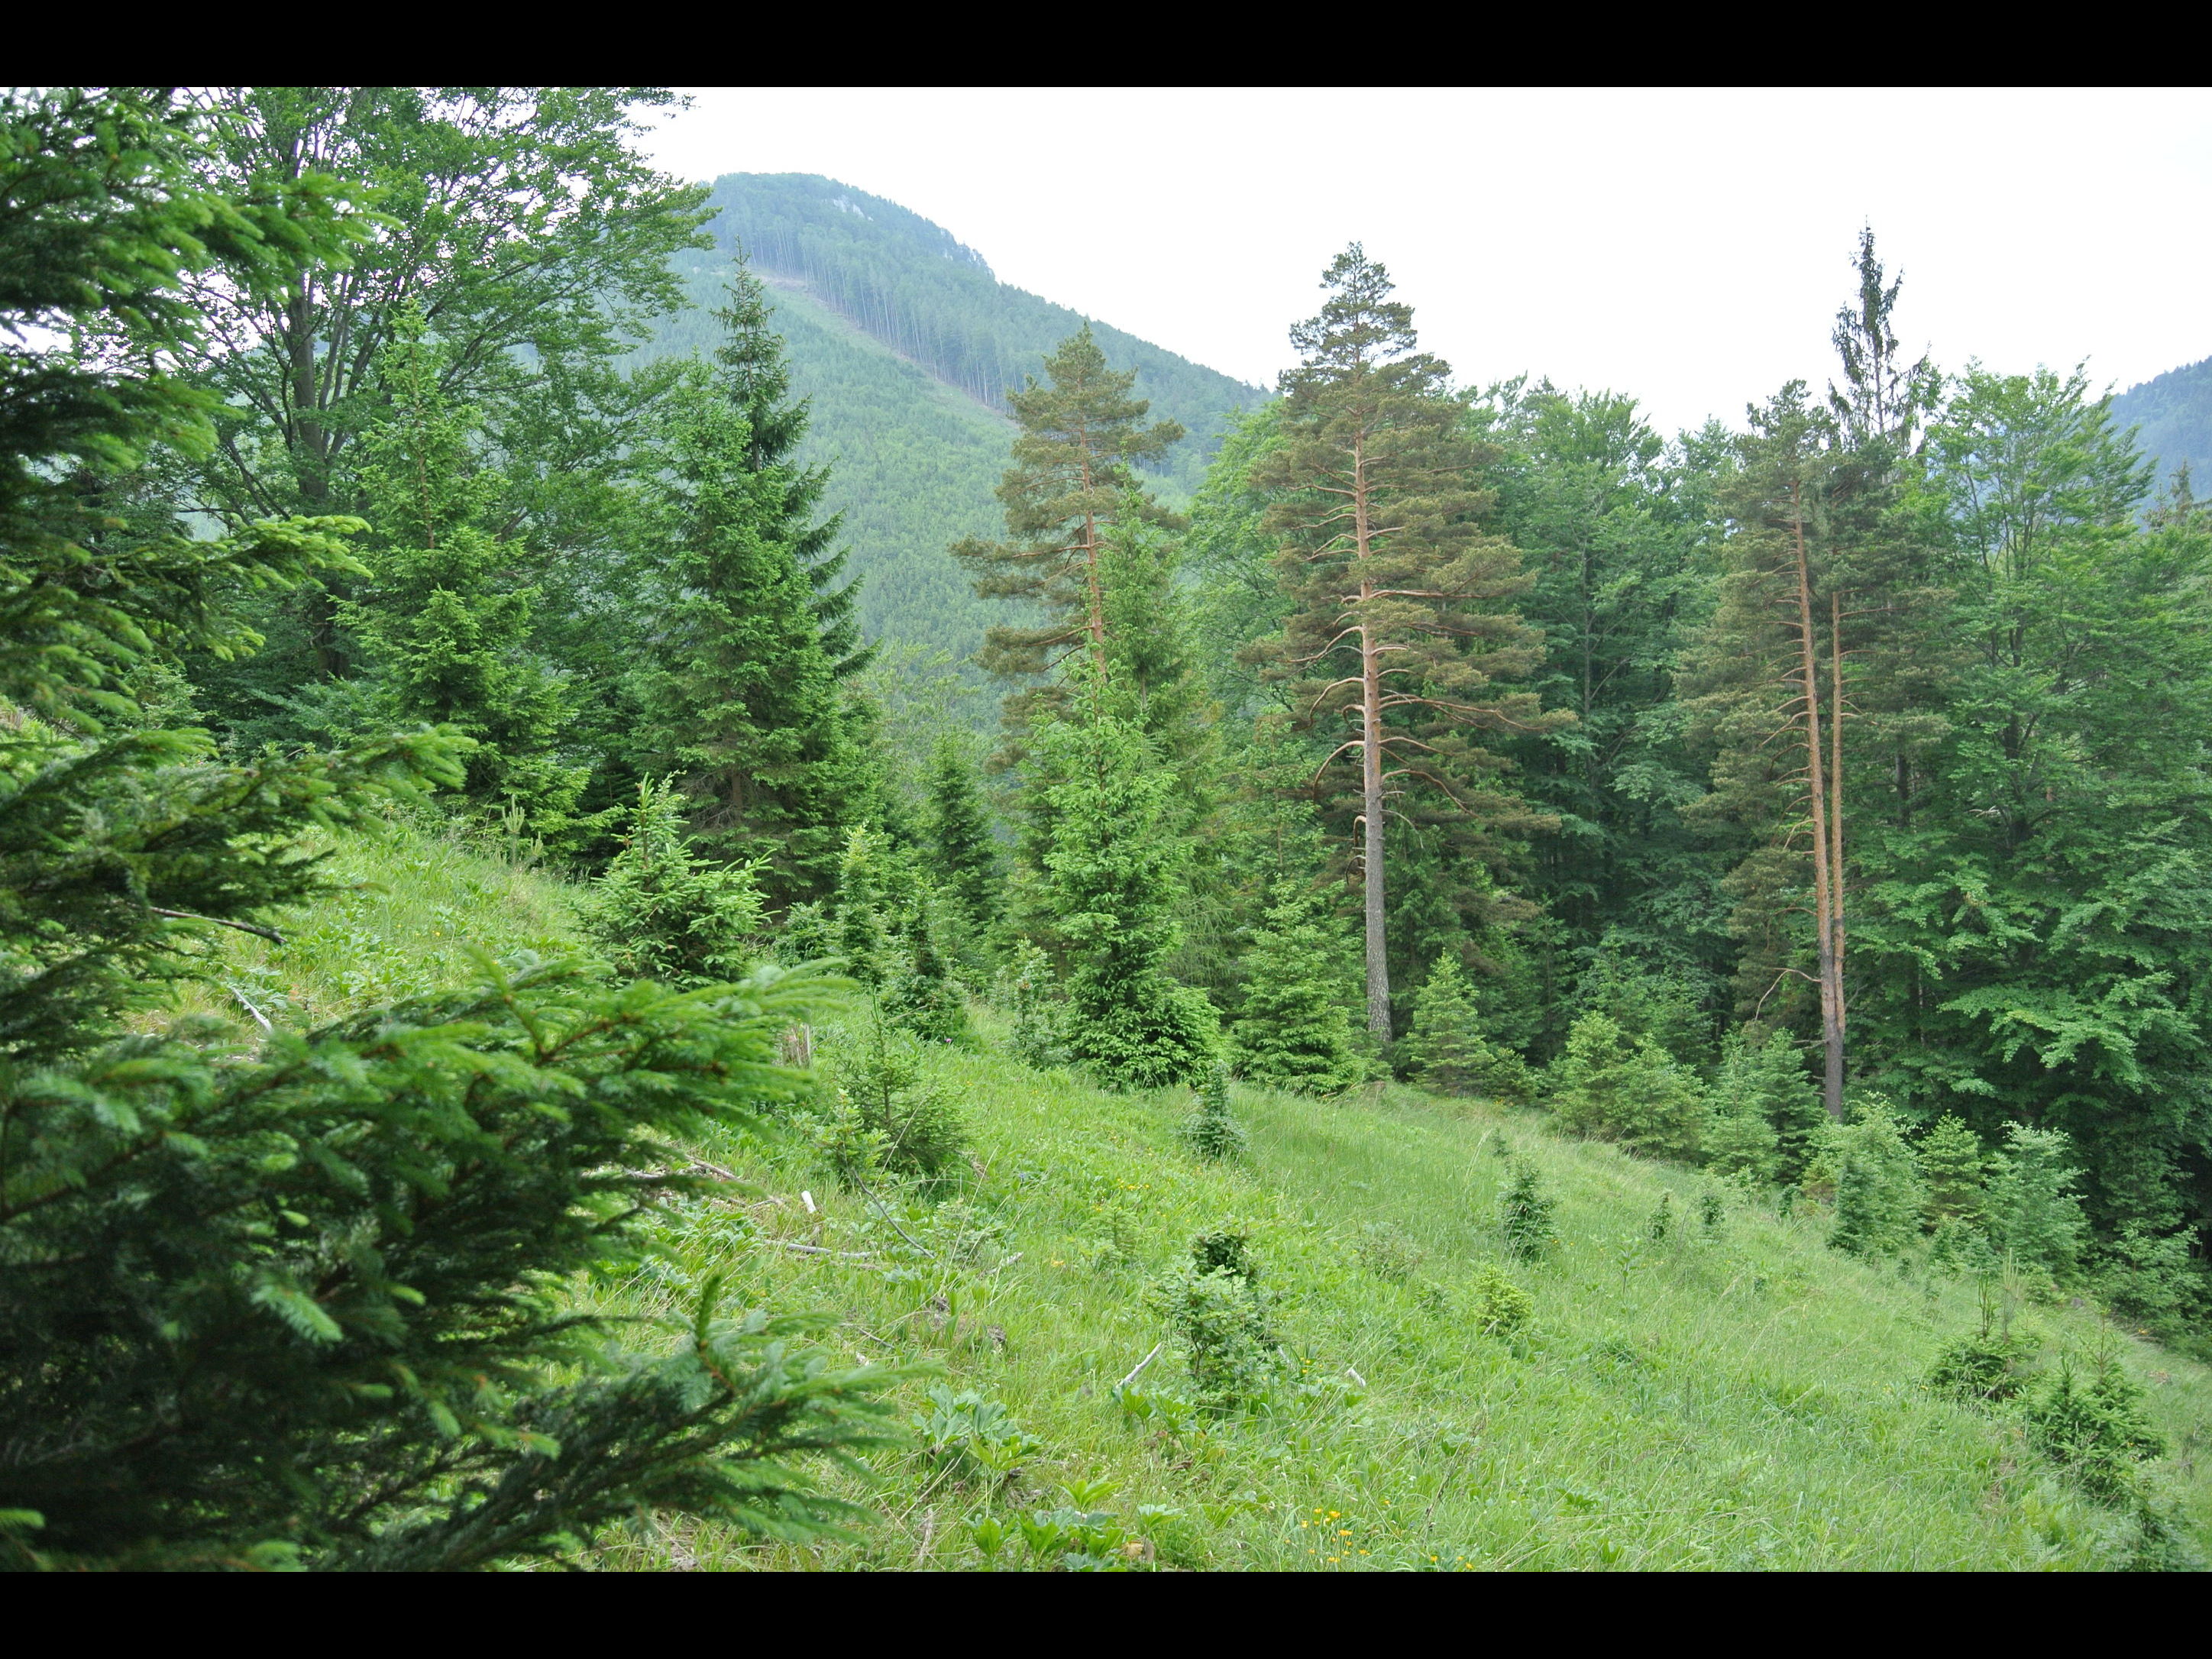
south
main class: Woodland
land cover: Spruce dominated coniferous woodland
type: alpine coniferous forest
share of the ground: > 75 %
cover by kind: coniferous forest trees 90 %, herbaceous plants 10 %
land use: Forestry
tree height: > 5 m
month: June
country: AT
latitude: 47.9281
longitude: 15.7710
